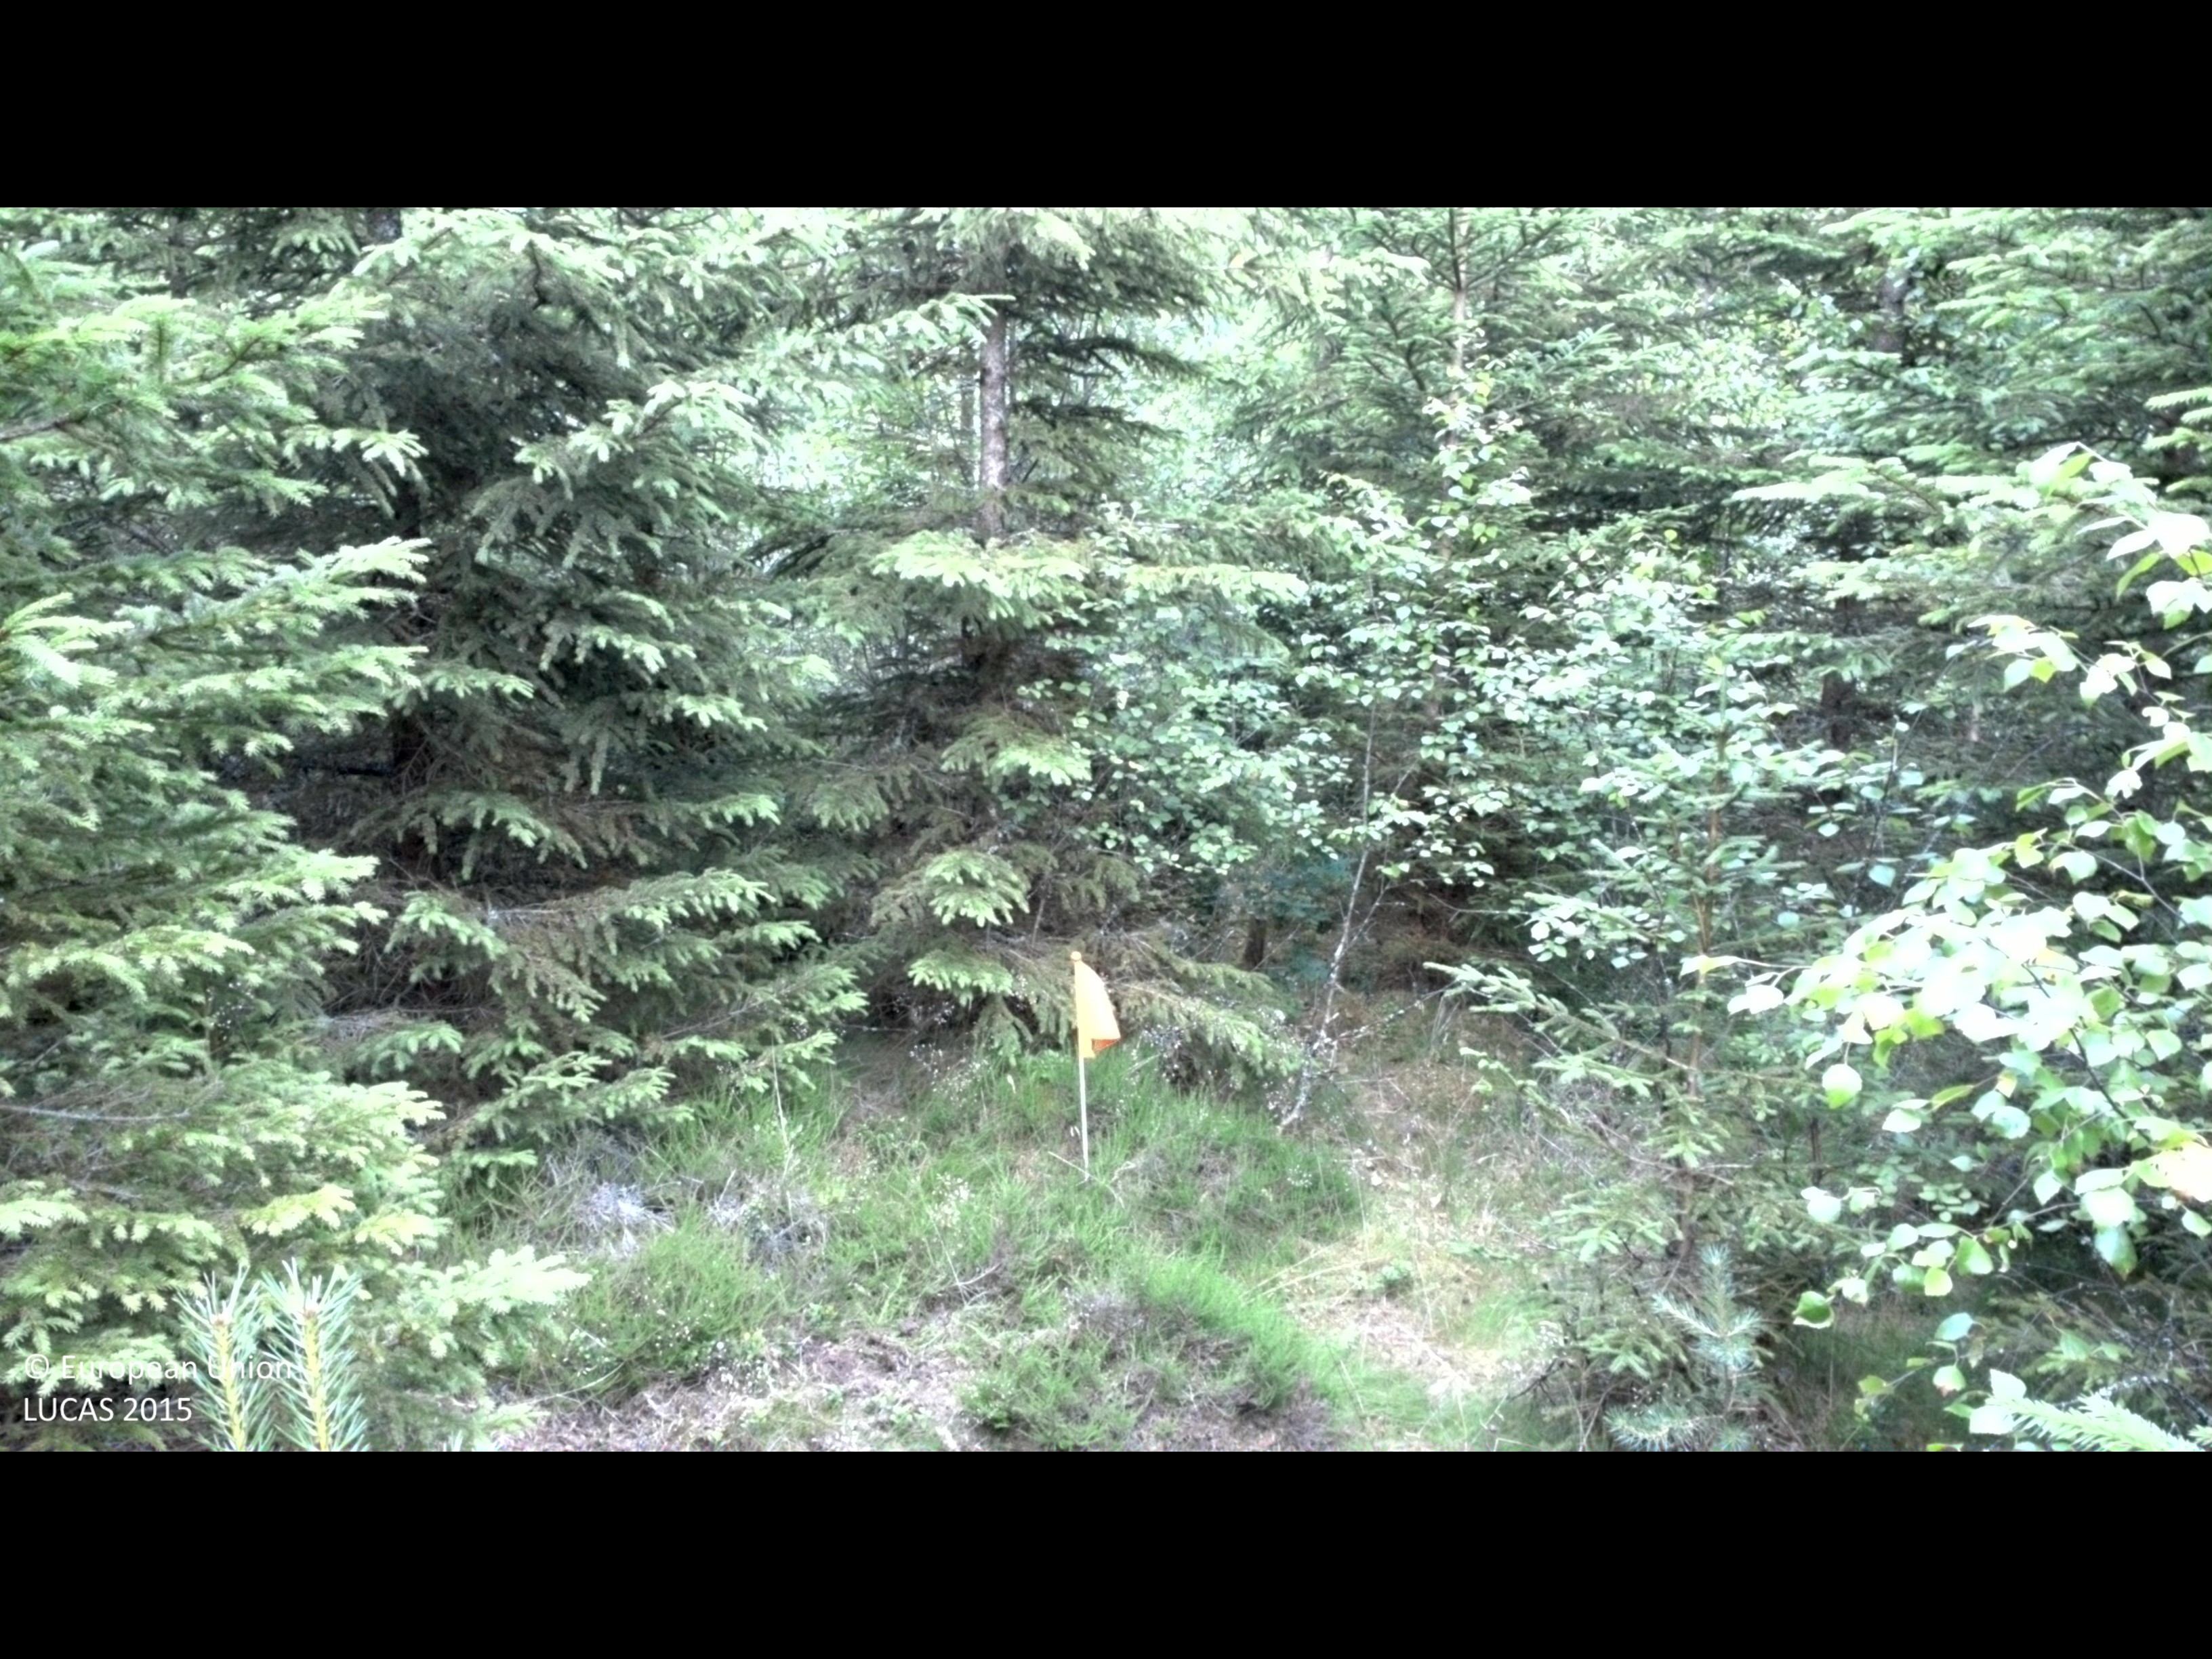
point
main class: Woodland
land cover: Spruce dominated mixed woodland
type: boreal forest
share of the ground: > 75 %
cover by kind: coniferous forest trees 45 %, broadleaved forest trees 35 %, shrubs 10 %, herbaceous plants 5 %, lichens and mosses 5 %
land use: Forestry
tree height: < 5 m
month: July
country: SE
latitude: 56.6509
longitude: 14.4499
